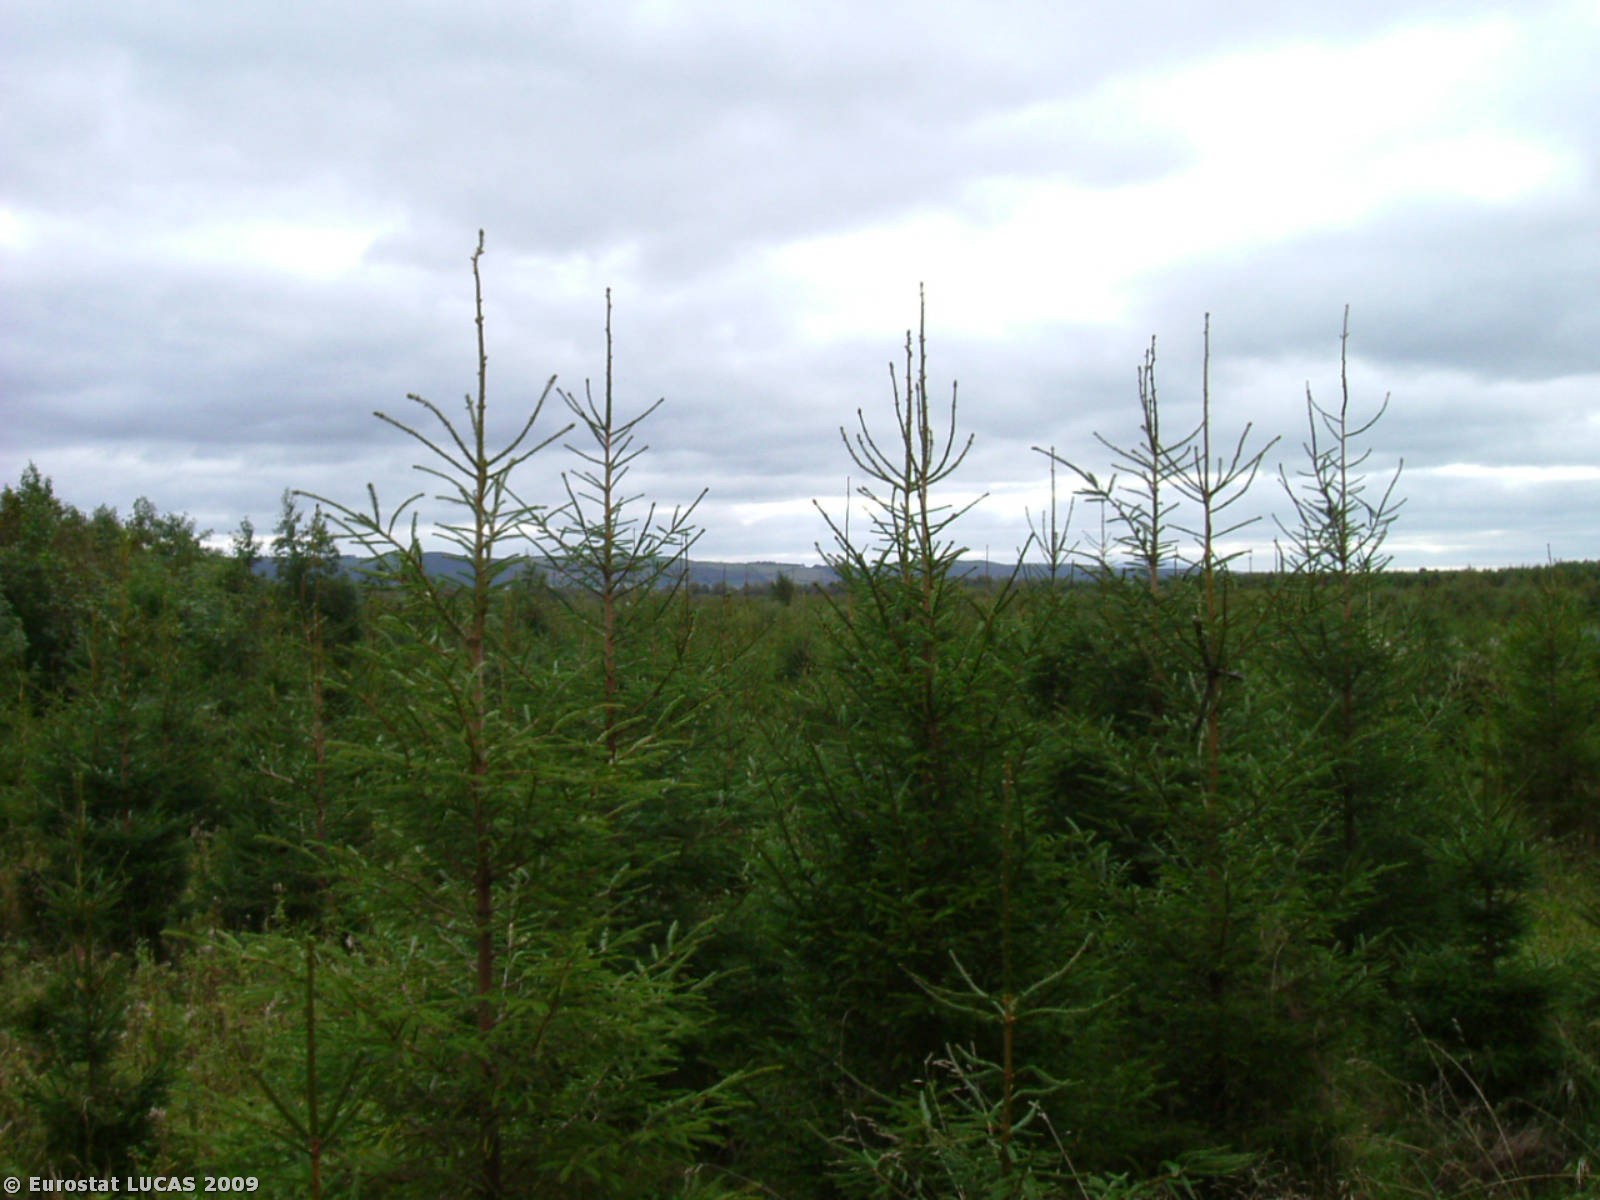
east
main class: Woodland
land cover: Coniferous woodland
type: plantations and self-sown exotic forest
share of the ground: > 75 %
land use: Forestry
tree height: > 5 m
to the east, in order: Coniferous woodland
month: October
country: IE
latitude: 52.6564
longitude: -7.6833
